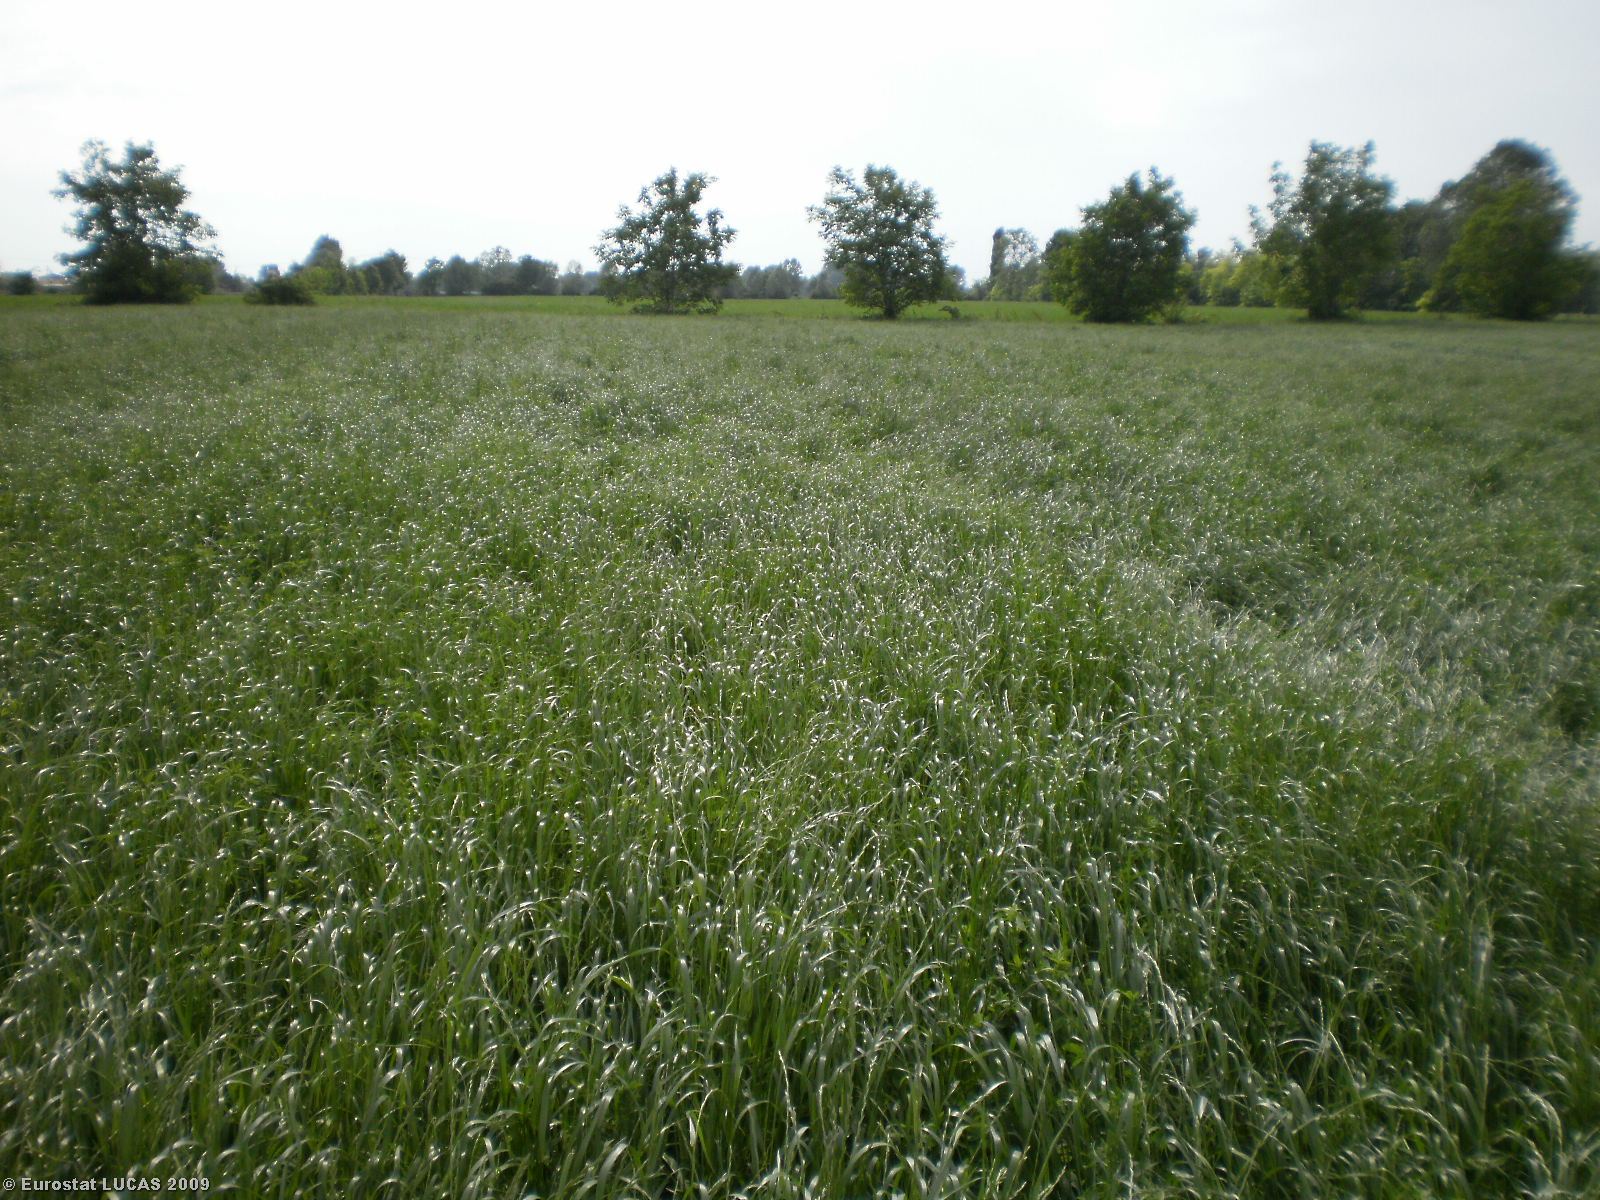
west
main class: Cropland
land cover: Mixed cereals for fodder
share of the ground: > 75 %
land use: Agriculture (excluding fallow land and kitchen gardens)
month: May
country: IT
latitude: 45.2334
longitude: 10.3687
